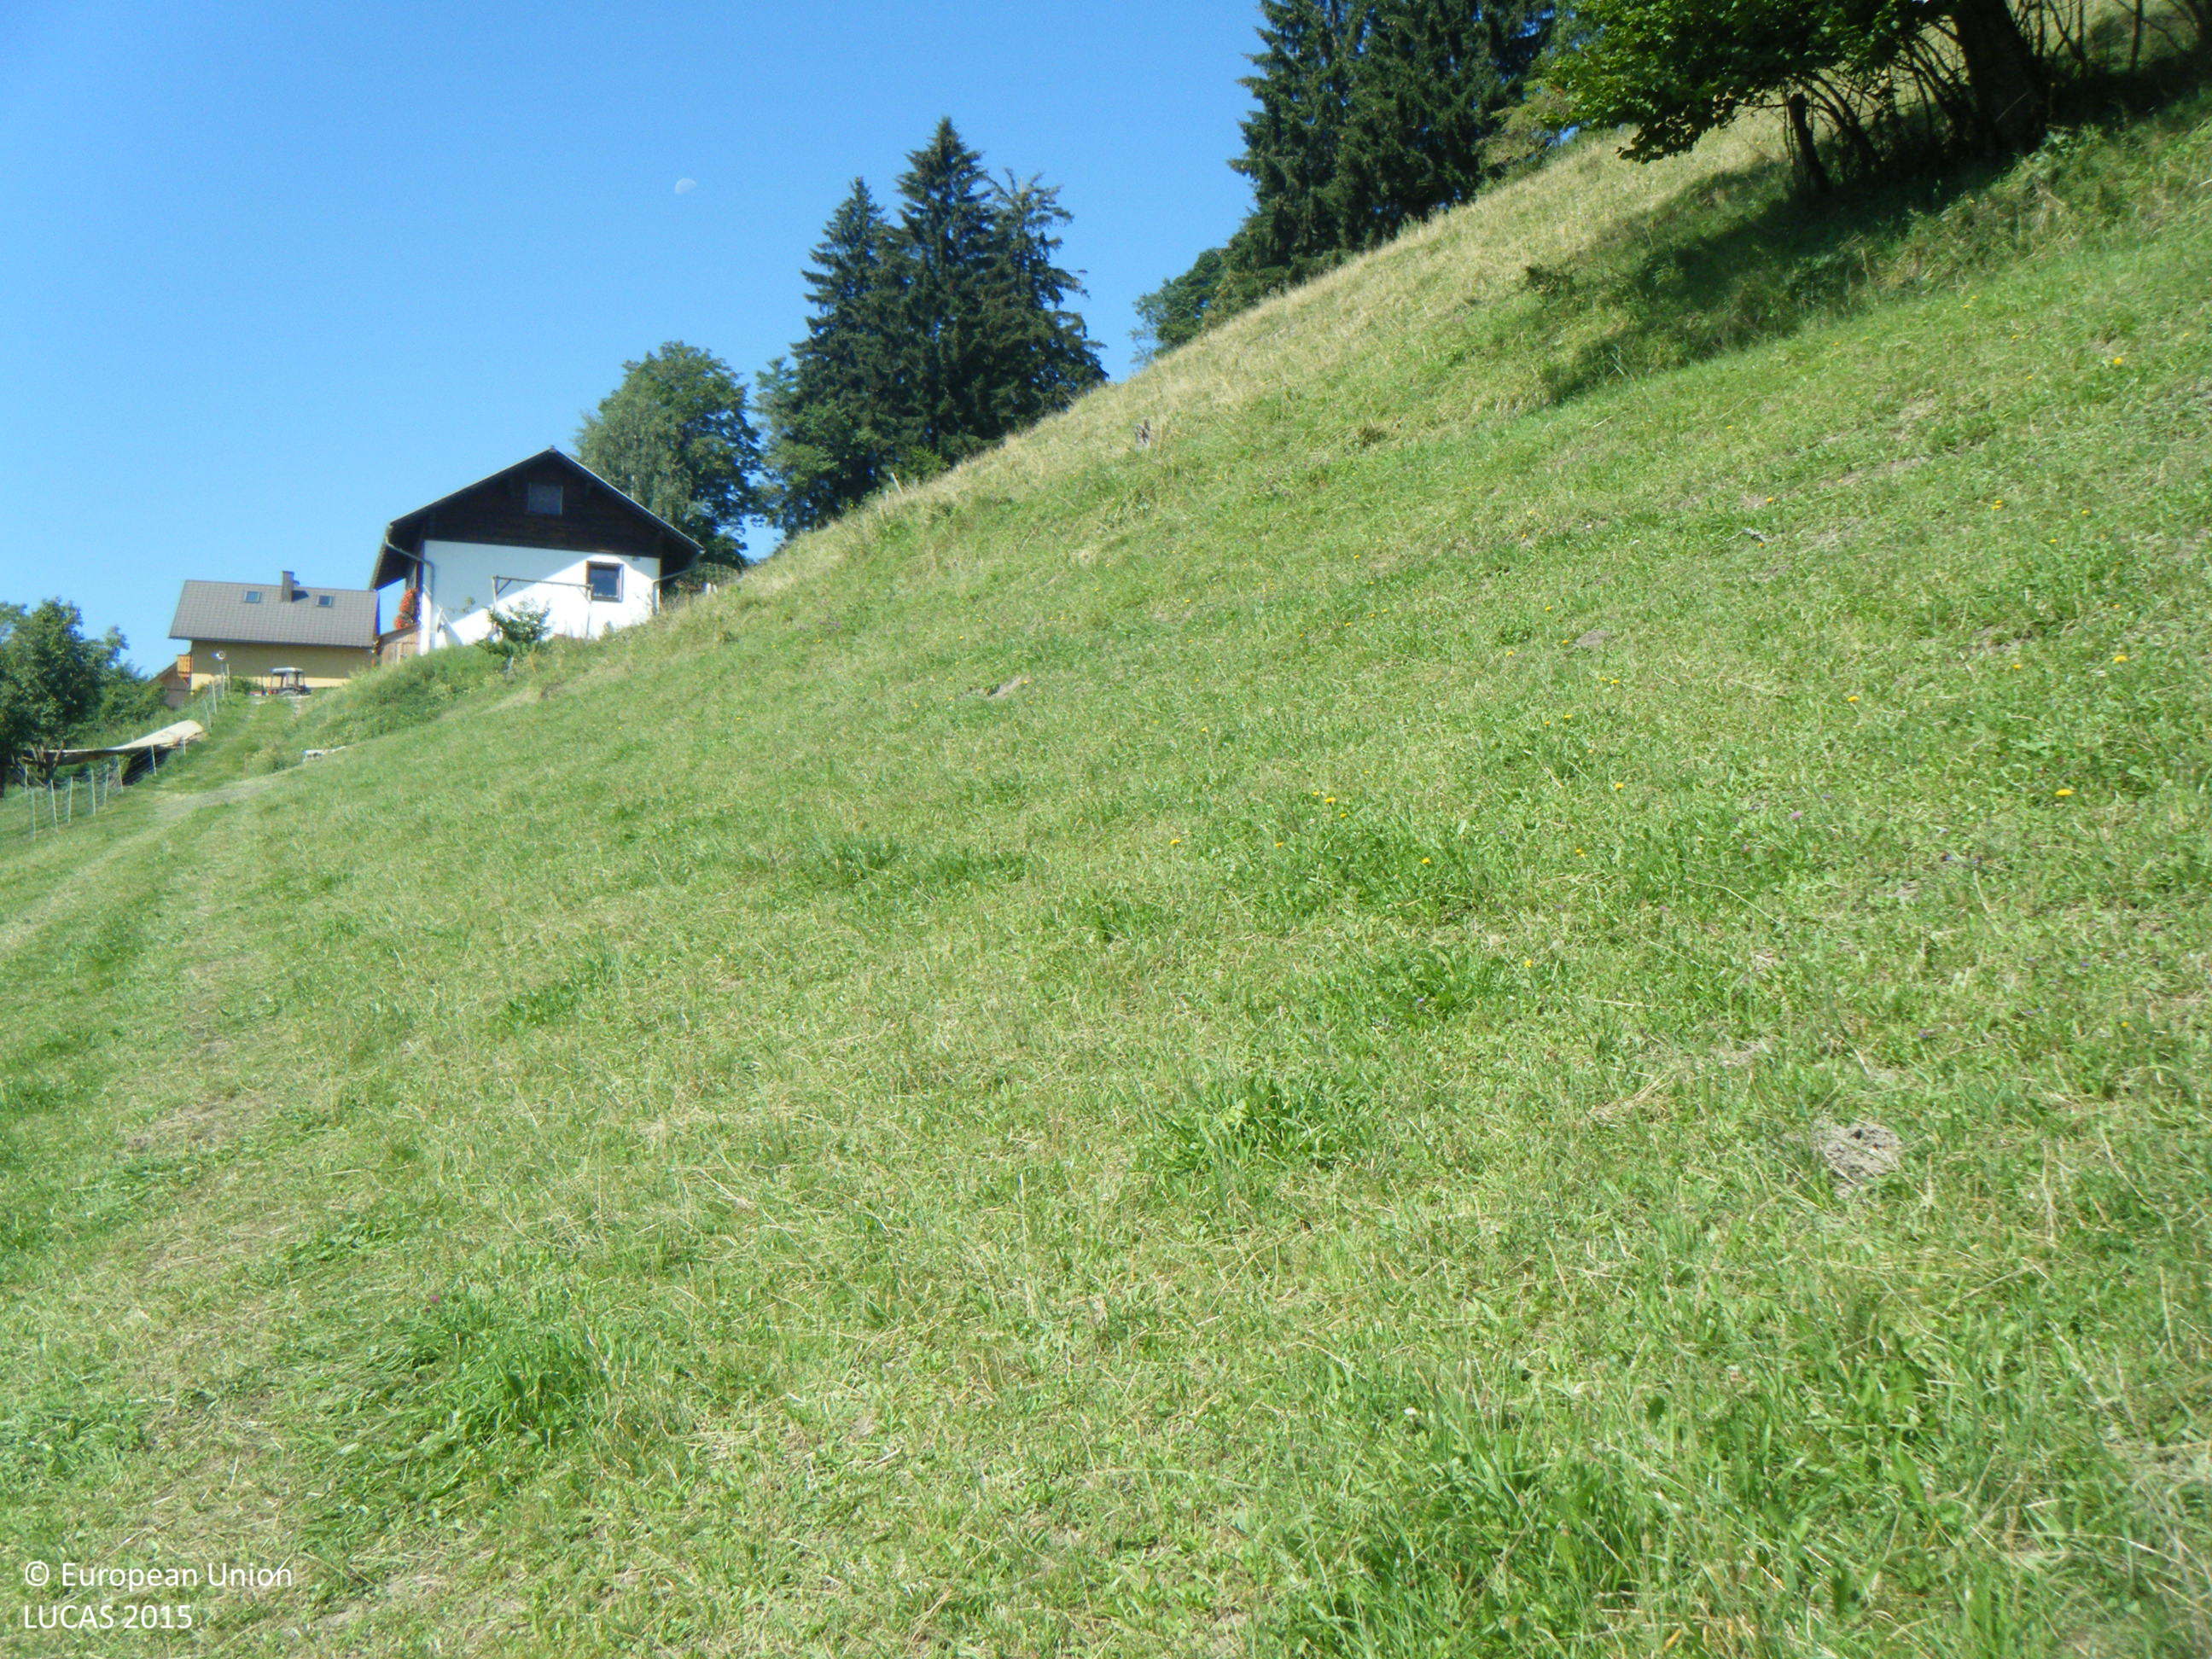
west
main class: Grassland
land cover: Grassland without tree/shrub cover
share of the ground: > 75 %
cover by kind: herbaceous plants 100 %
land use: Agriculture (excluding fallow land and kitchen gardens)
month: August
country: AT
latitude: 47.5564
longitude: 13.9989
